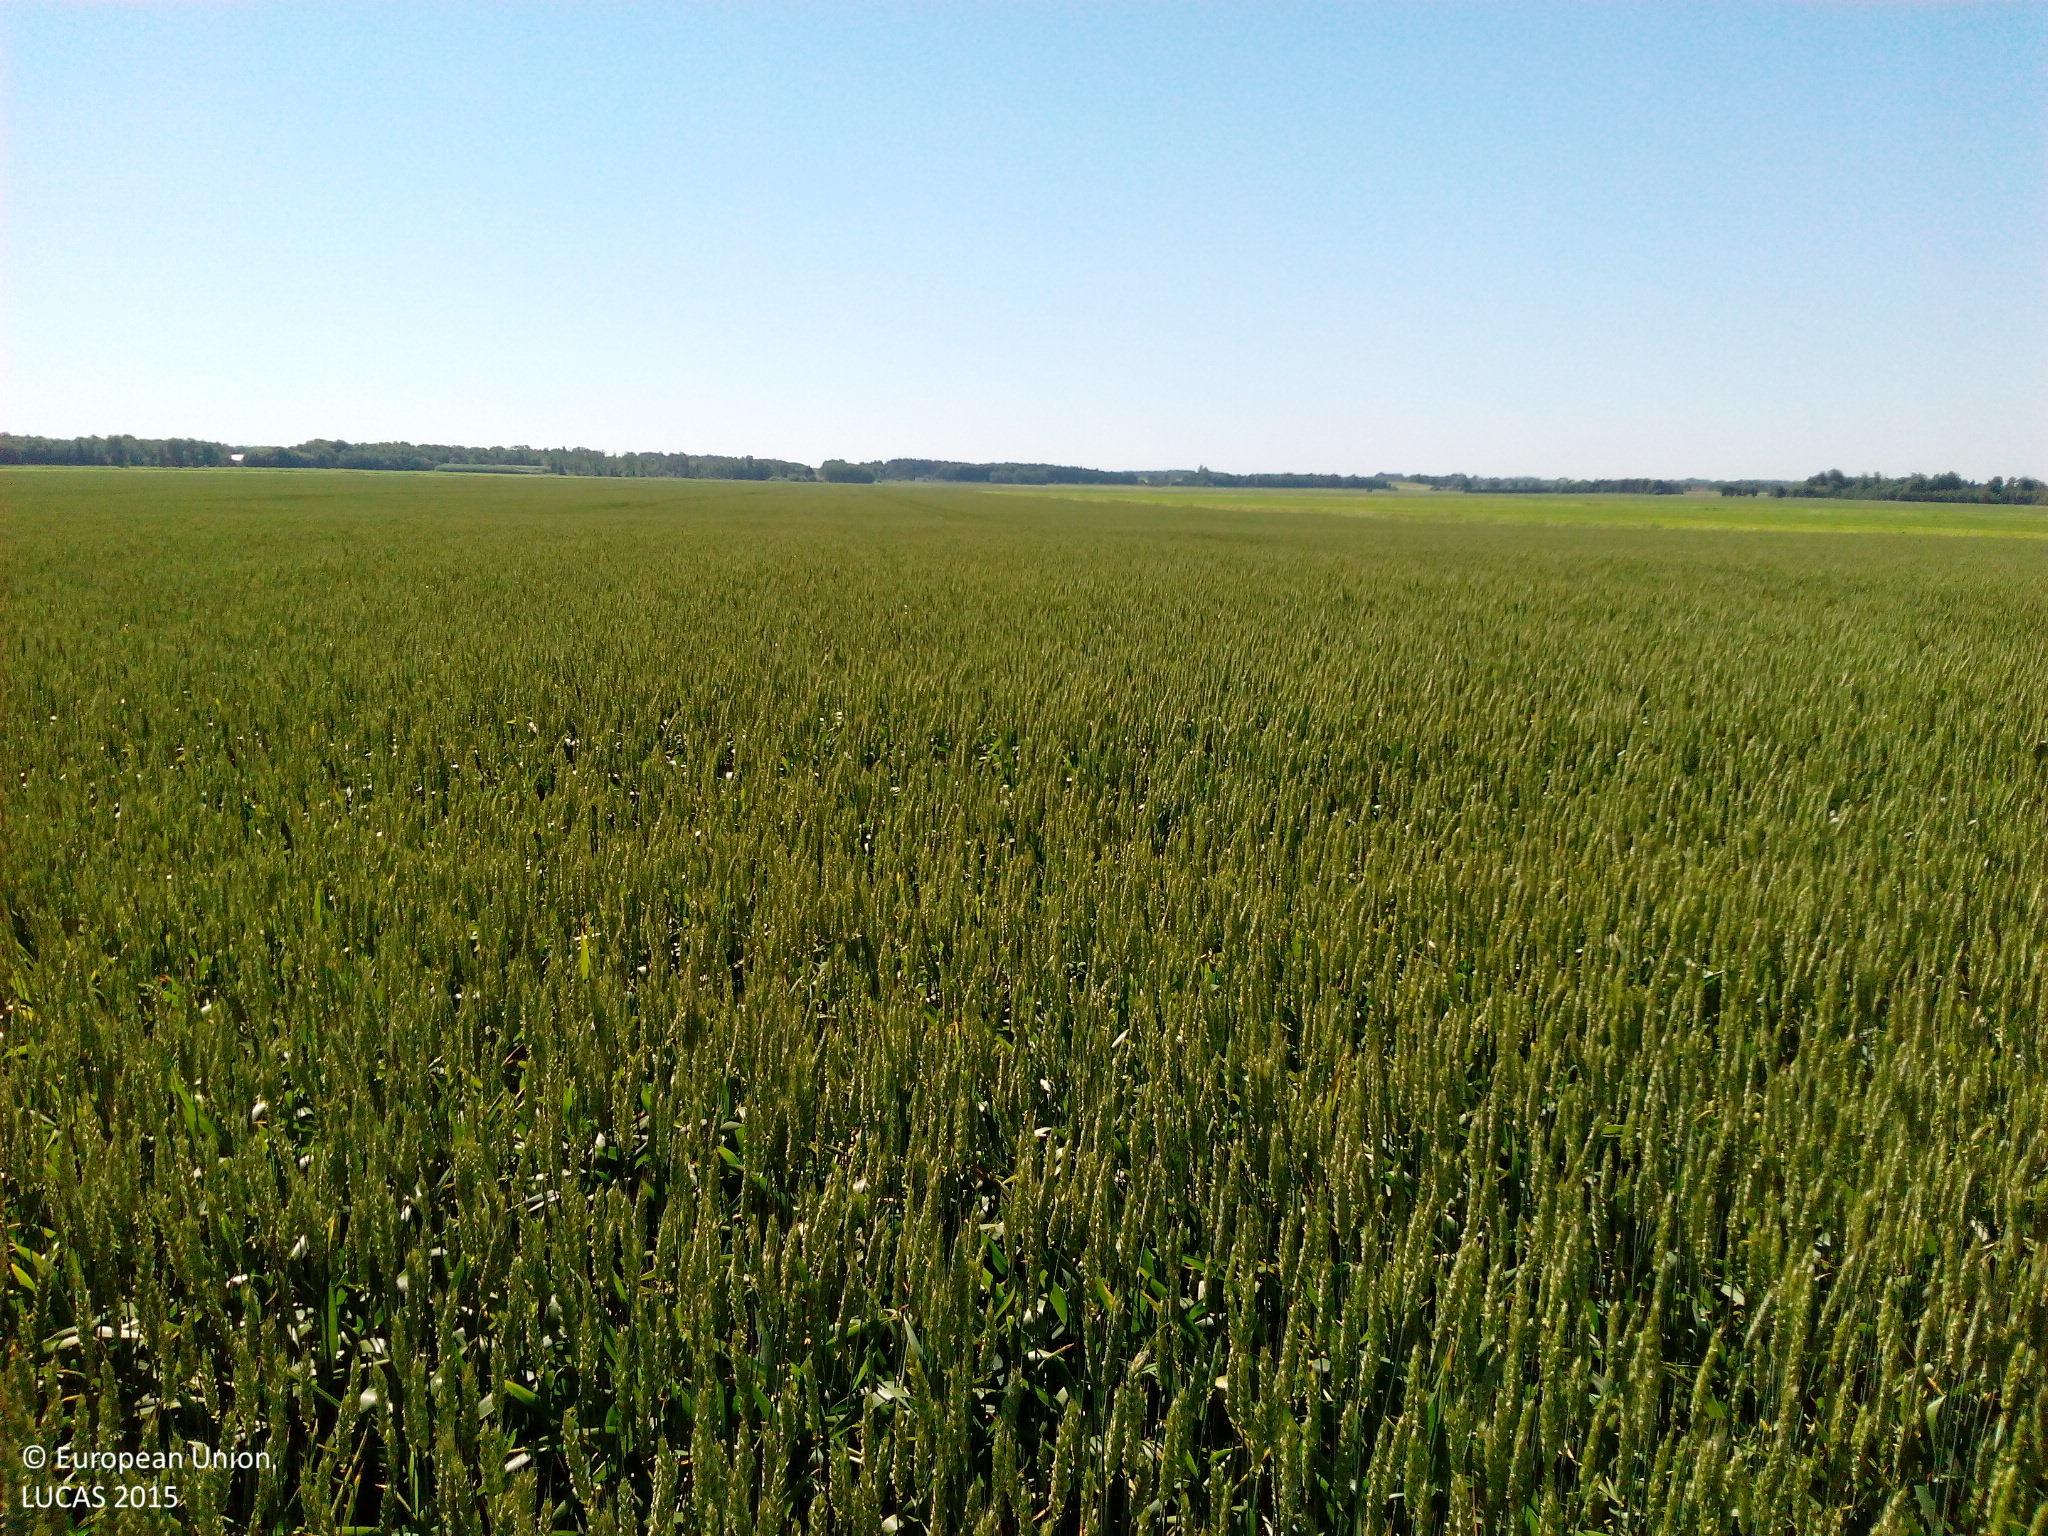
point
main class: Cropland
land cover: Common wheat
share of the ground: > 75 %
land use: Agriculture (excluding fallow land and kitchen gardens)
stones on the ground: 10 - 25 %
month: July
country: DK
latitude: 56.3838
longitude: 10.6632
